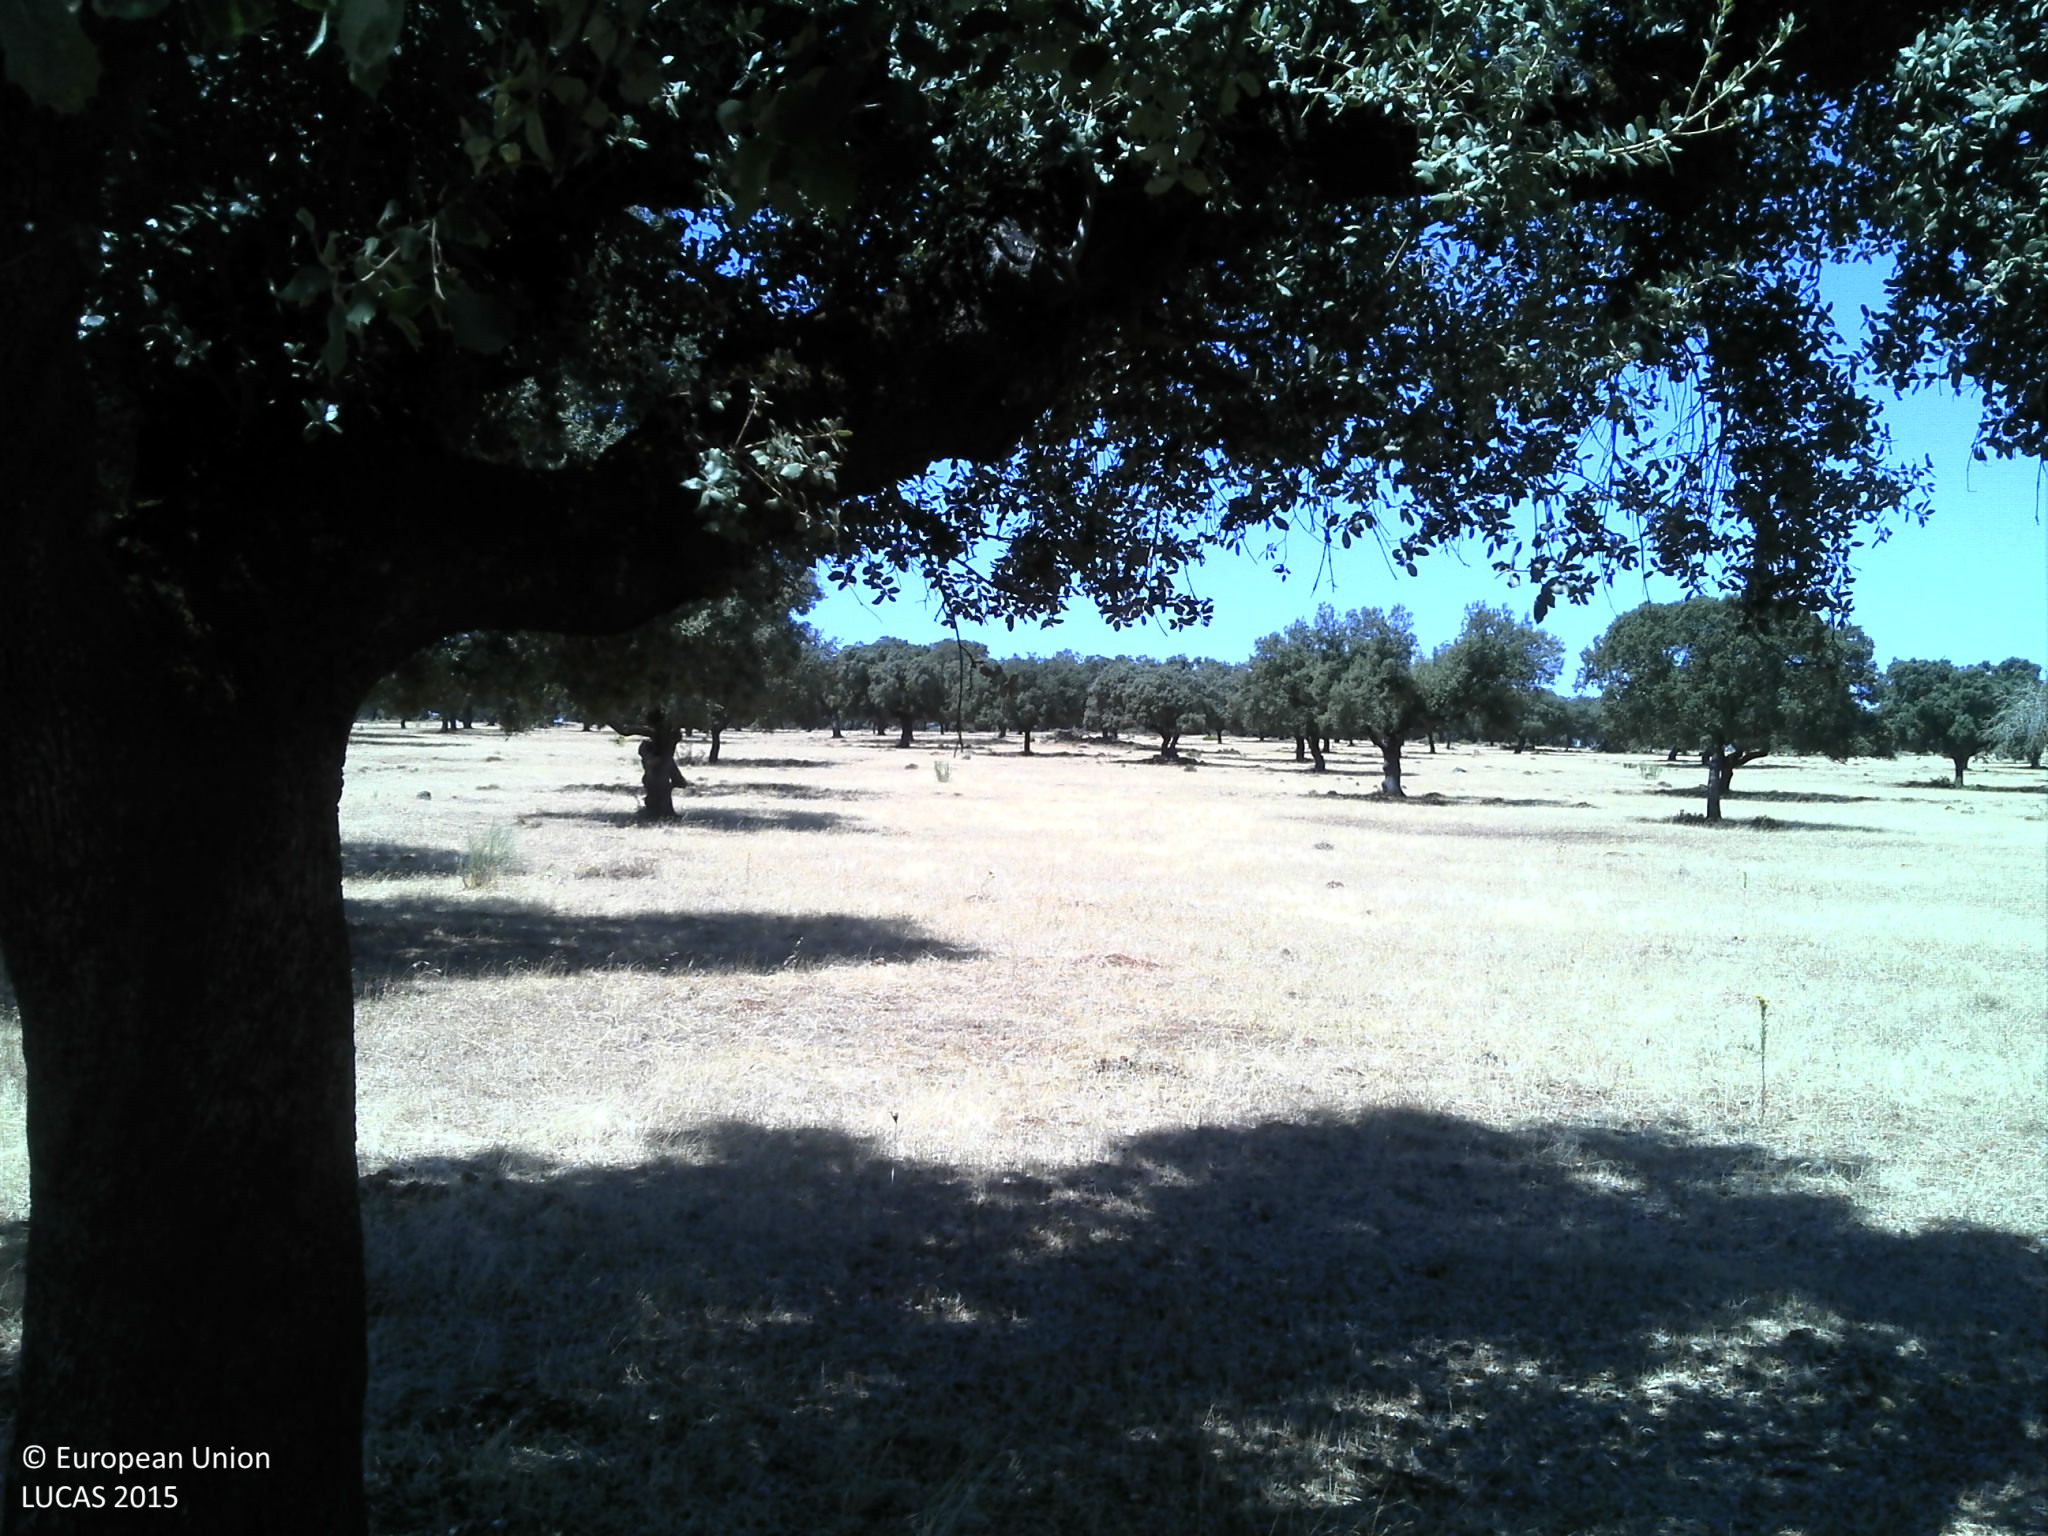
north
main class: Woodland
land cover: Broadleaved woodland
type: broadleaved evergreen forest
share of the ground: 10 - 25 %
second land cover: Grassland without tree/shrub cover
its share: 10 - 25 %
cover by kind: unconsolidated bare surface 70 %, broadleaved forest trees 15 %, herbaceous plants 15 %
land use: Forestry
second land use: Agriculture (excluding fallow land and kitchen gardens)
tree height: > 5 m
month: July
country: PT
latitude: 39.1164
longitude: -7.5397
